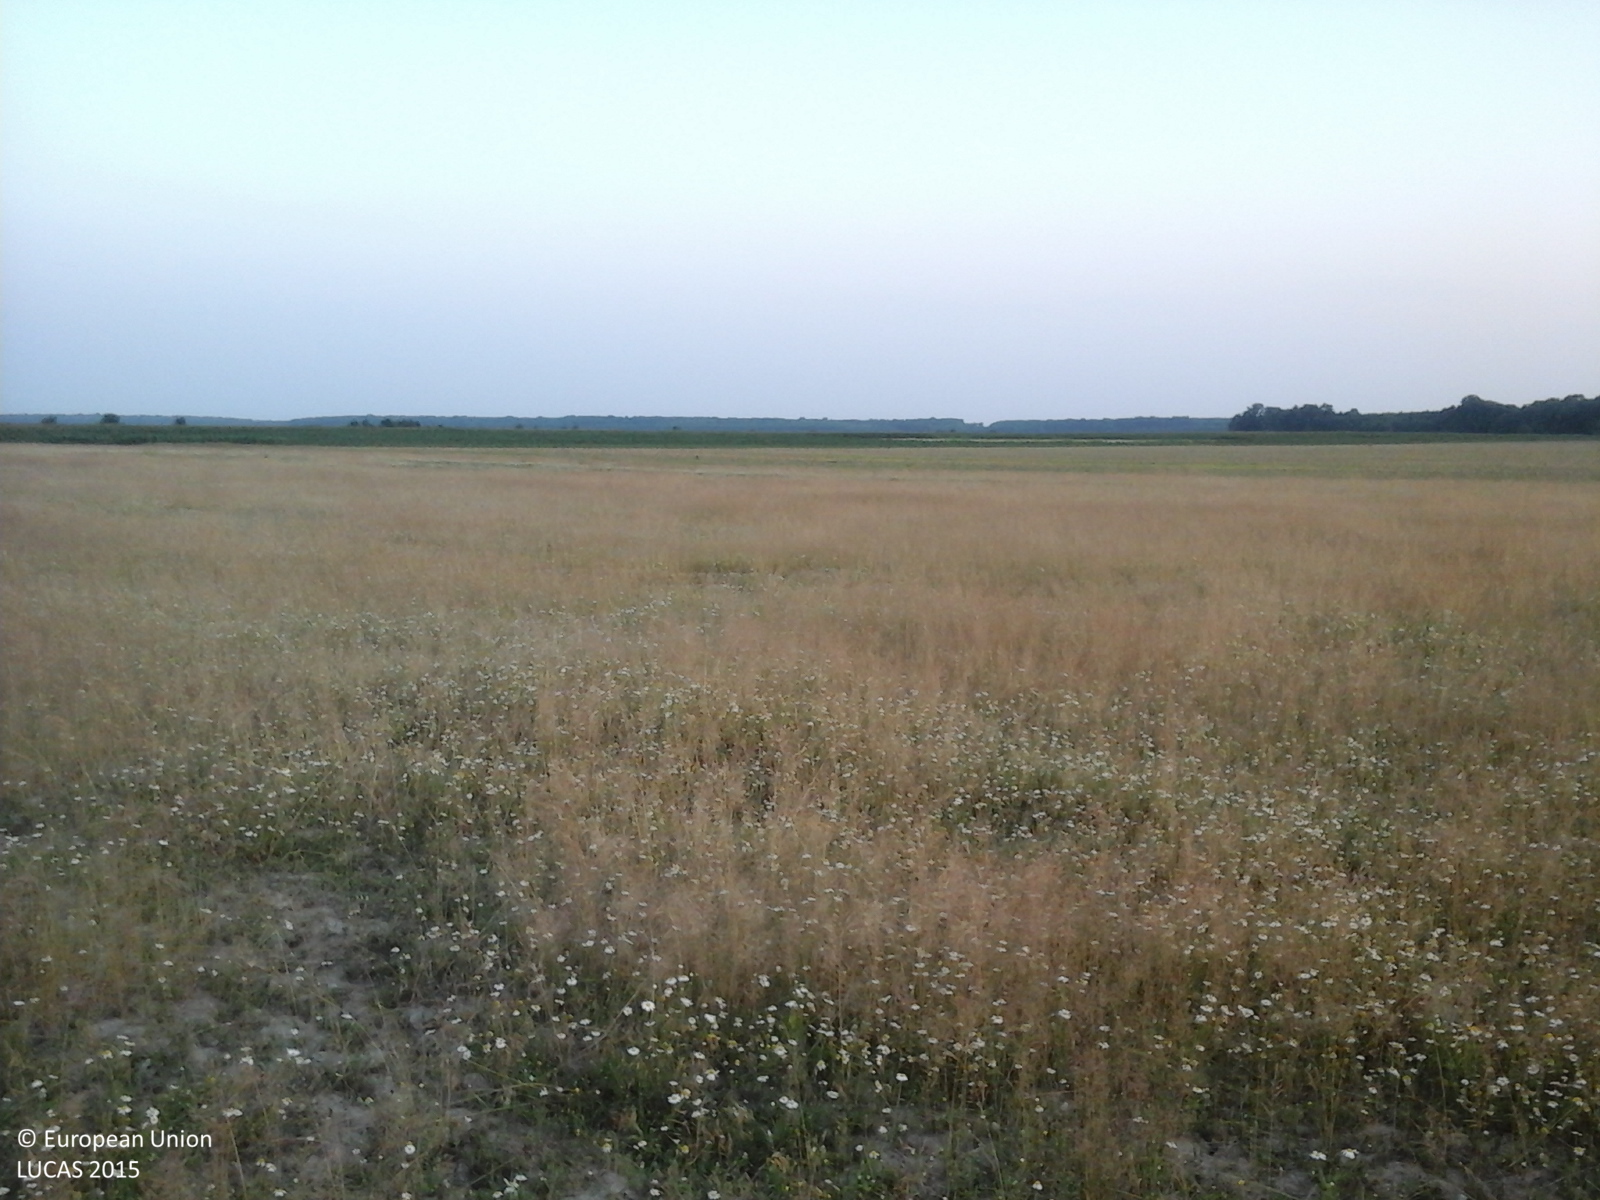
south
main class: Grassland
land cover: Grassland without tree/shrub cover
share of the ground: > 75 %
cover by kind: herbaceous plants 100 %
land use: Agriculture (excluding fallow land and kitchen gardens)
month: July
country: RO
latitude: 44.7318
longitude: 25.7704
